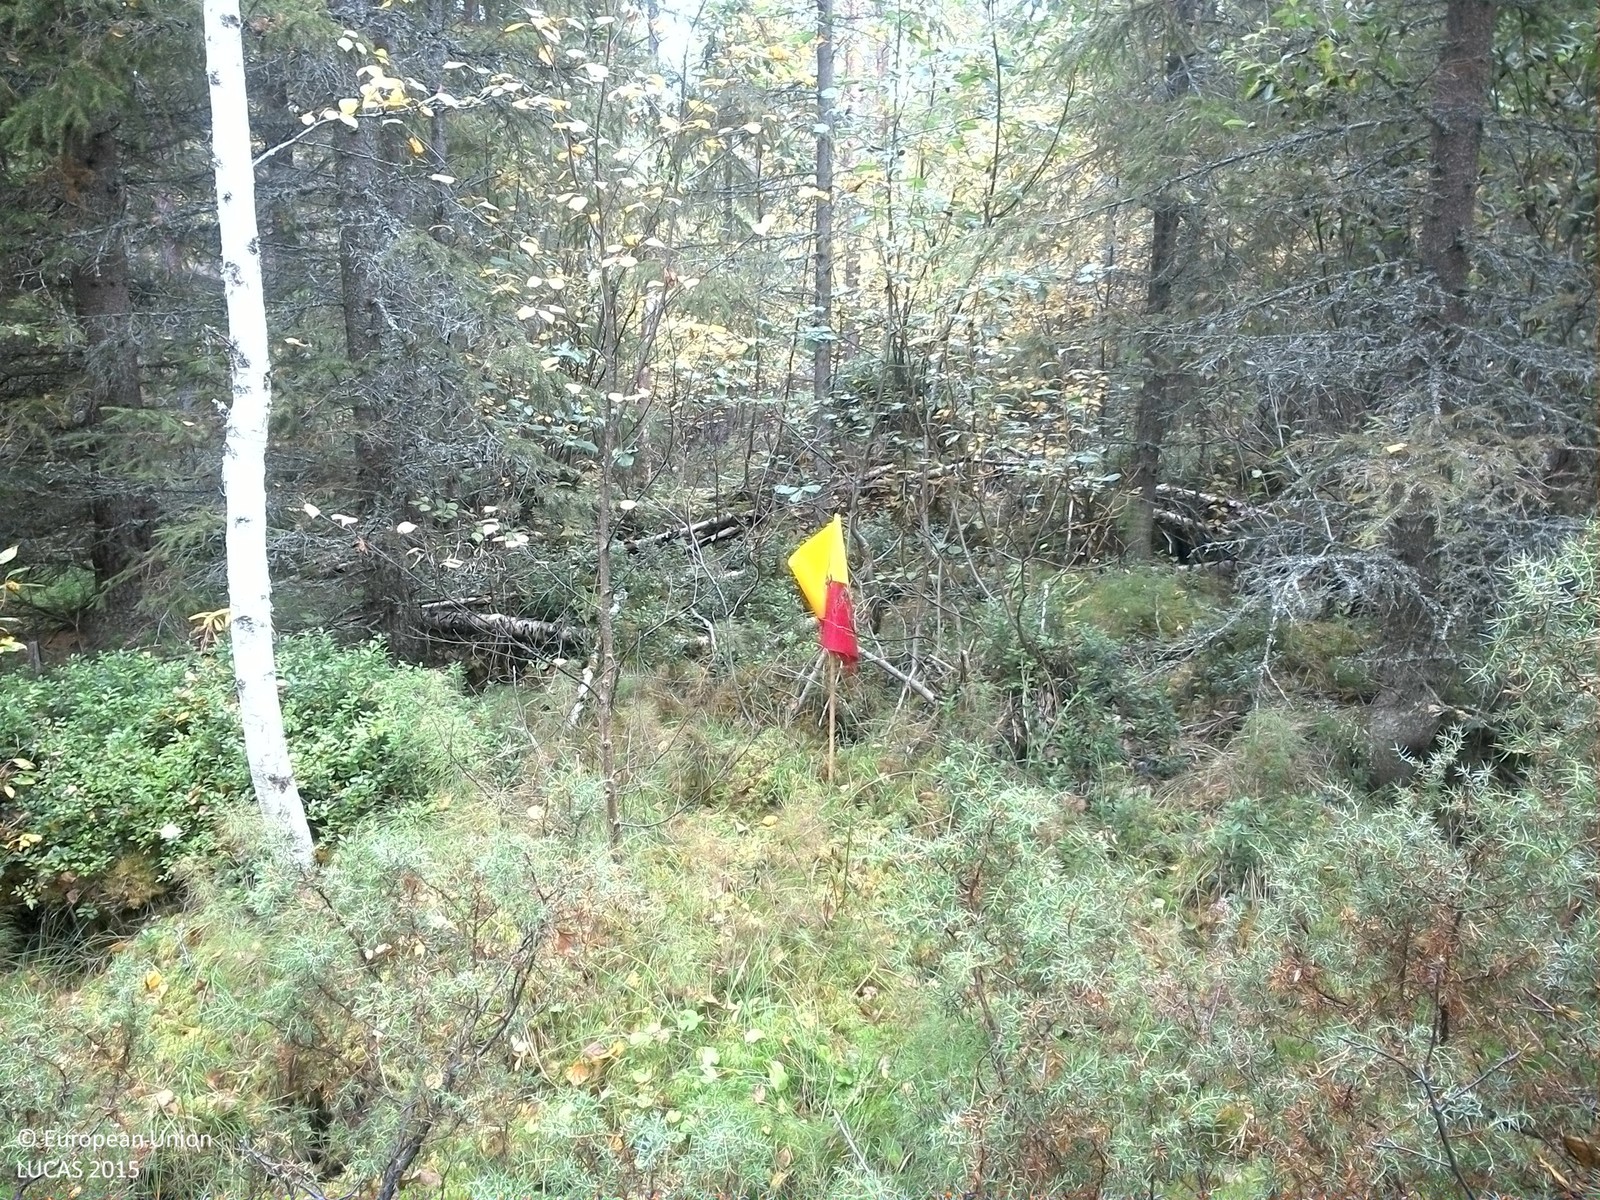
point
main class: Woodland
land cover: Spruce dominated mixed woodland
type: boreal forest
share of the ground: > 75 %
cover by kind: coniferous forest trees 45 %, broadleaved forest trees 30 %, shrubs 10 %, lichens and mosses 10 %, herbaceous plants 5 %
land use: Forestry
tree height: > 5 m
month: September
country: SE
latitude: 63.7324
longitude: 16.2307
